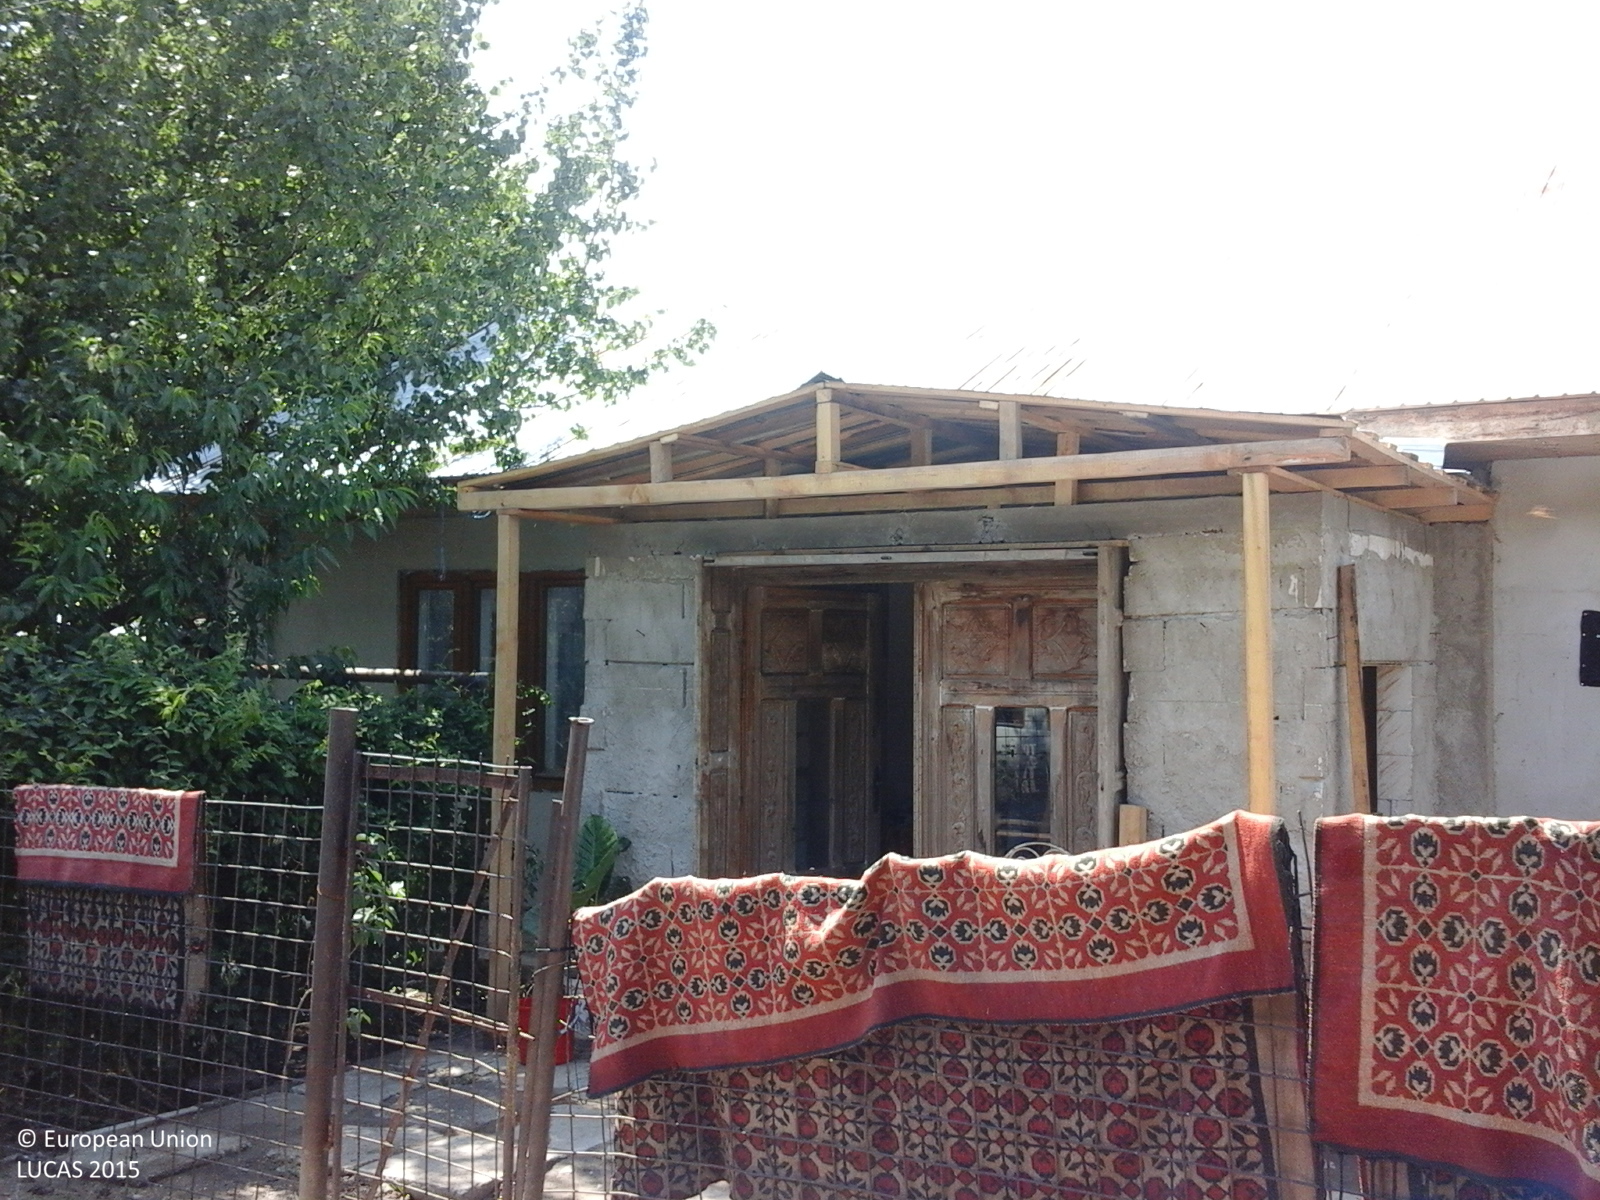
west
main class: Cropland
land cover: Apple fruit
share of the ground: 50 - 75 %
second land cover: Grassland without tree/shrub cover
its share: > 75 %
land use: Agriculture (excluding fallow land and kitchen gardens)
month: July
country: RO
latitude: 43.8976
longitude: 25.9439
